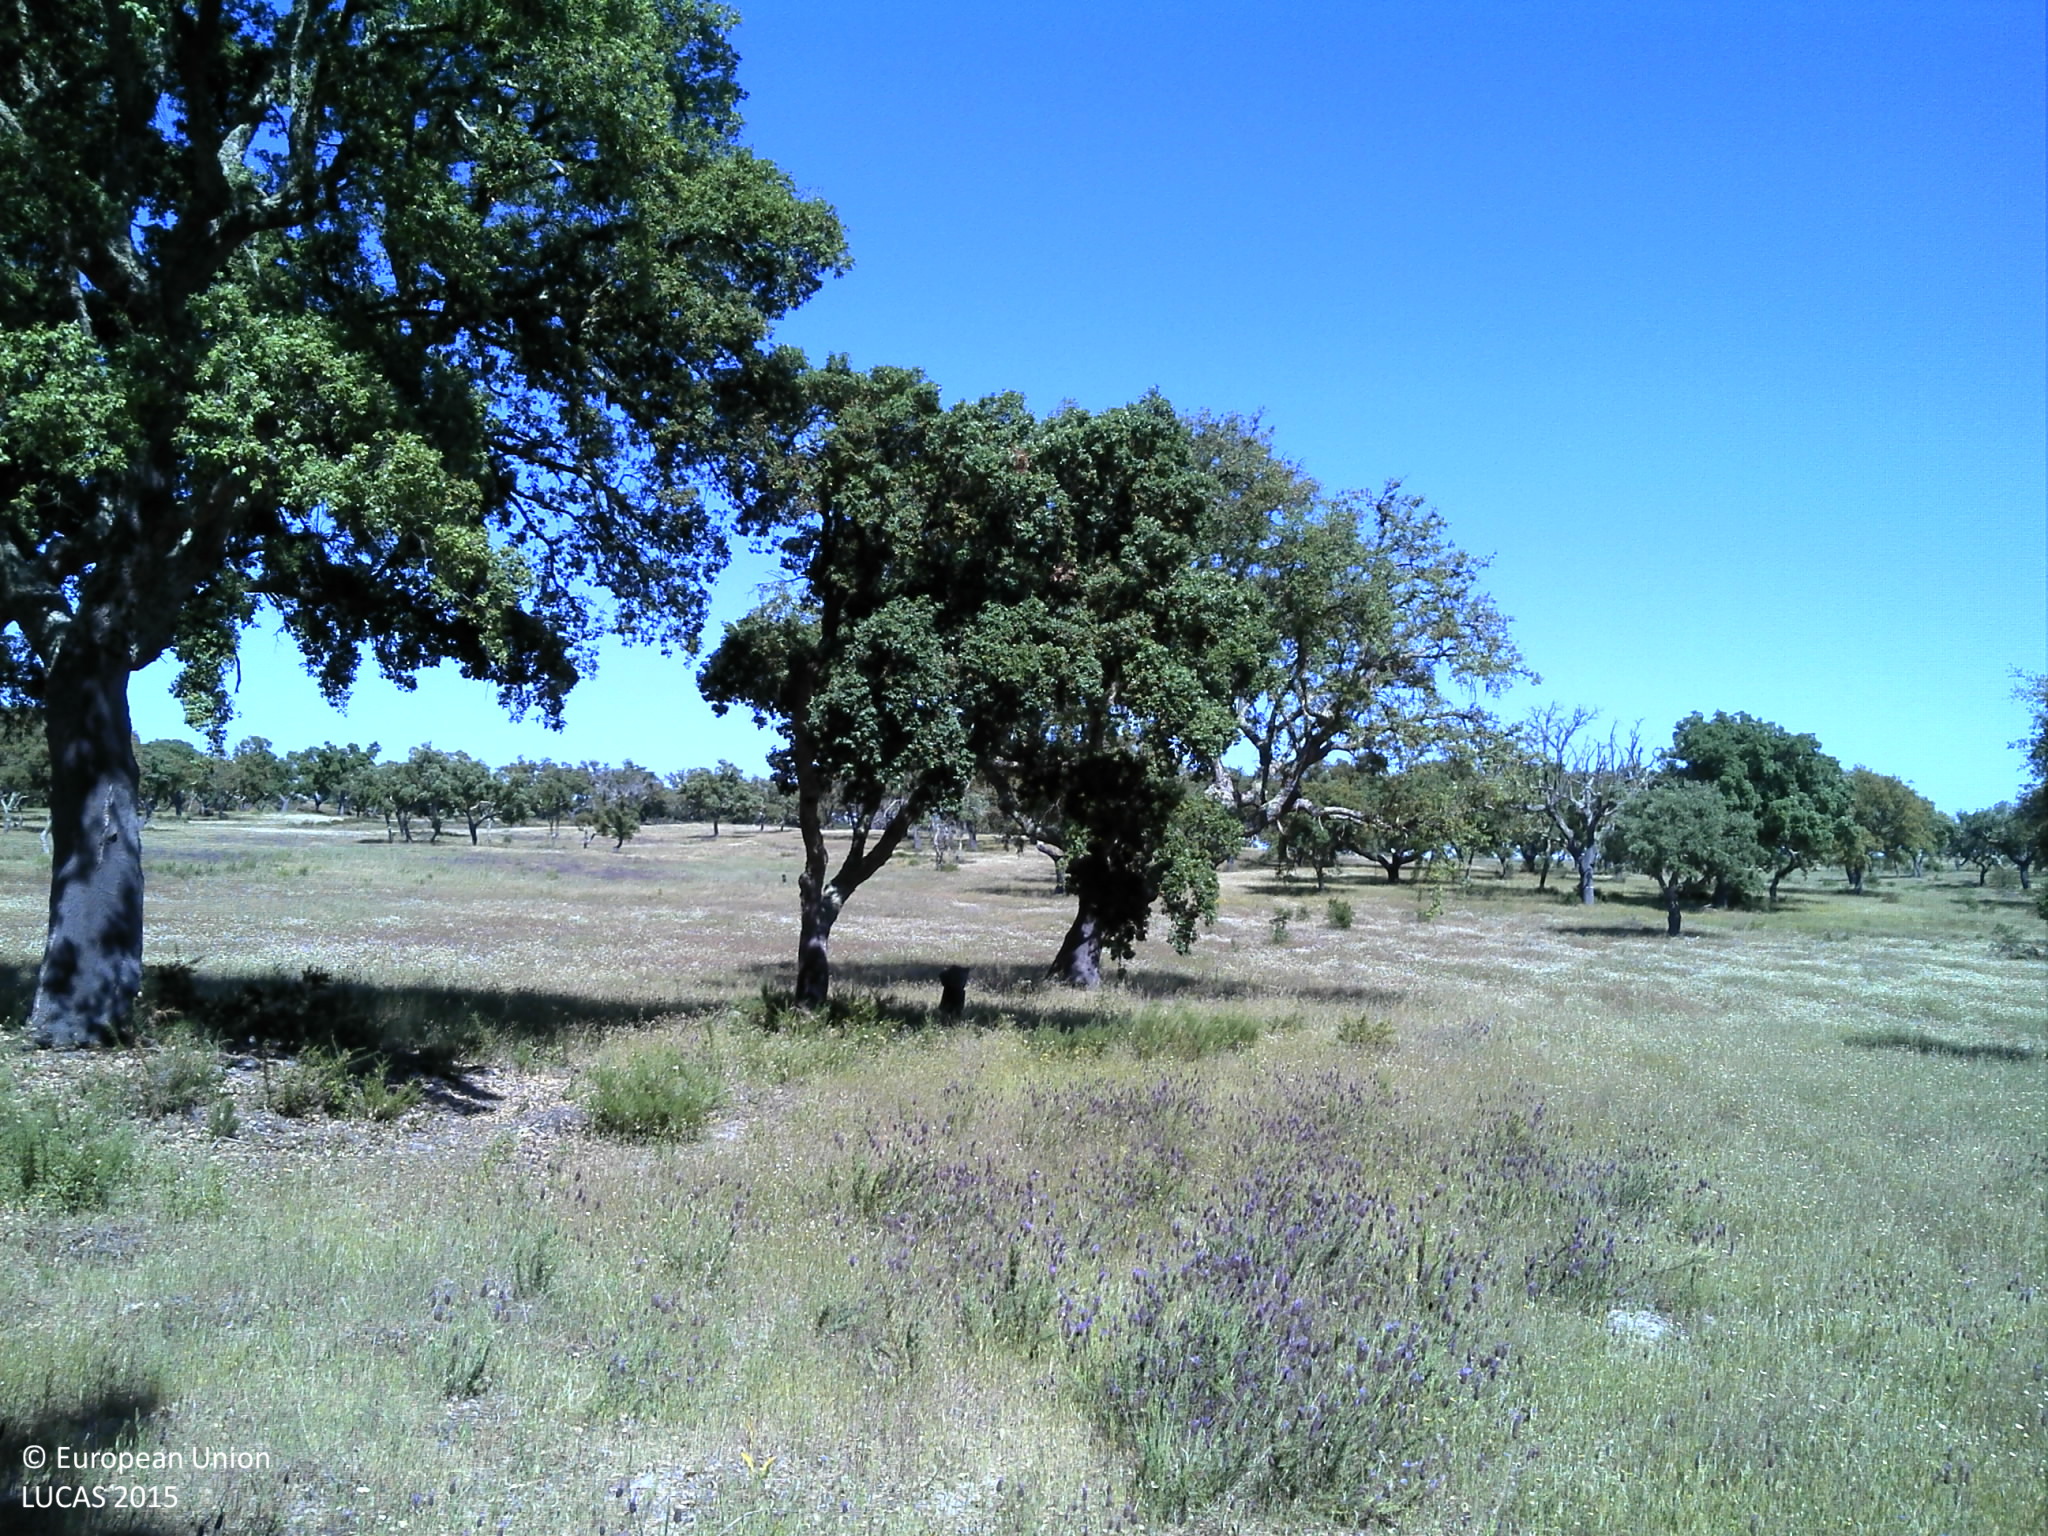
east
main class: Woodland
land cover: Broadleaved woodland
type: broadleaved evergreen forest
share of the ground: 25 - 50 %
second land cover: Grassland without tree/shrub cover
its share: 50 - 75 %
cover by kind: herbaceous plants 60 %, broadleaved forest trees 30 %, unconsolidated bare surface 10 %
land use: Forestry
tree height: > 5 m
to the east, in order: Broadleaved woodland; Grassland without tree/shrub cover; Broadleaved woodland; Grassland without tree/shrub cover; Broadleaved woodland
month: May
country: PT
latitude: 39.1414
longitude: -7.9022
